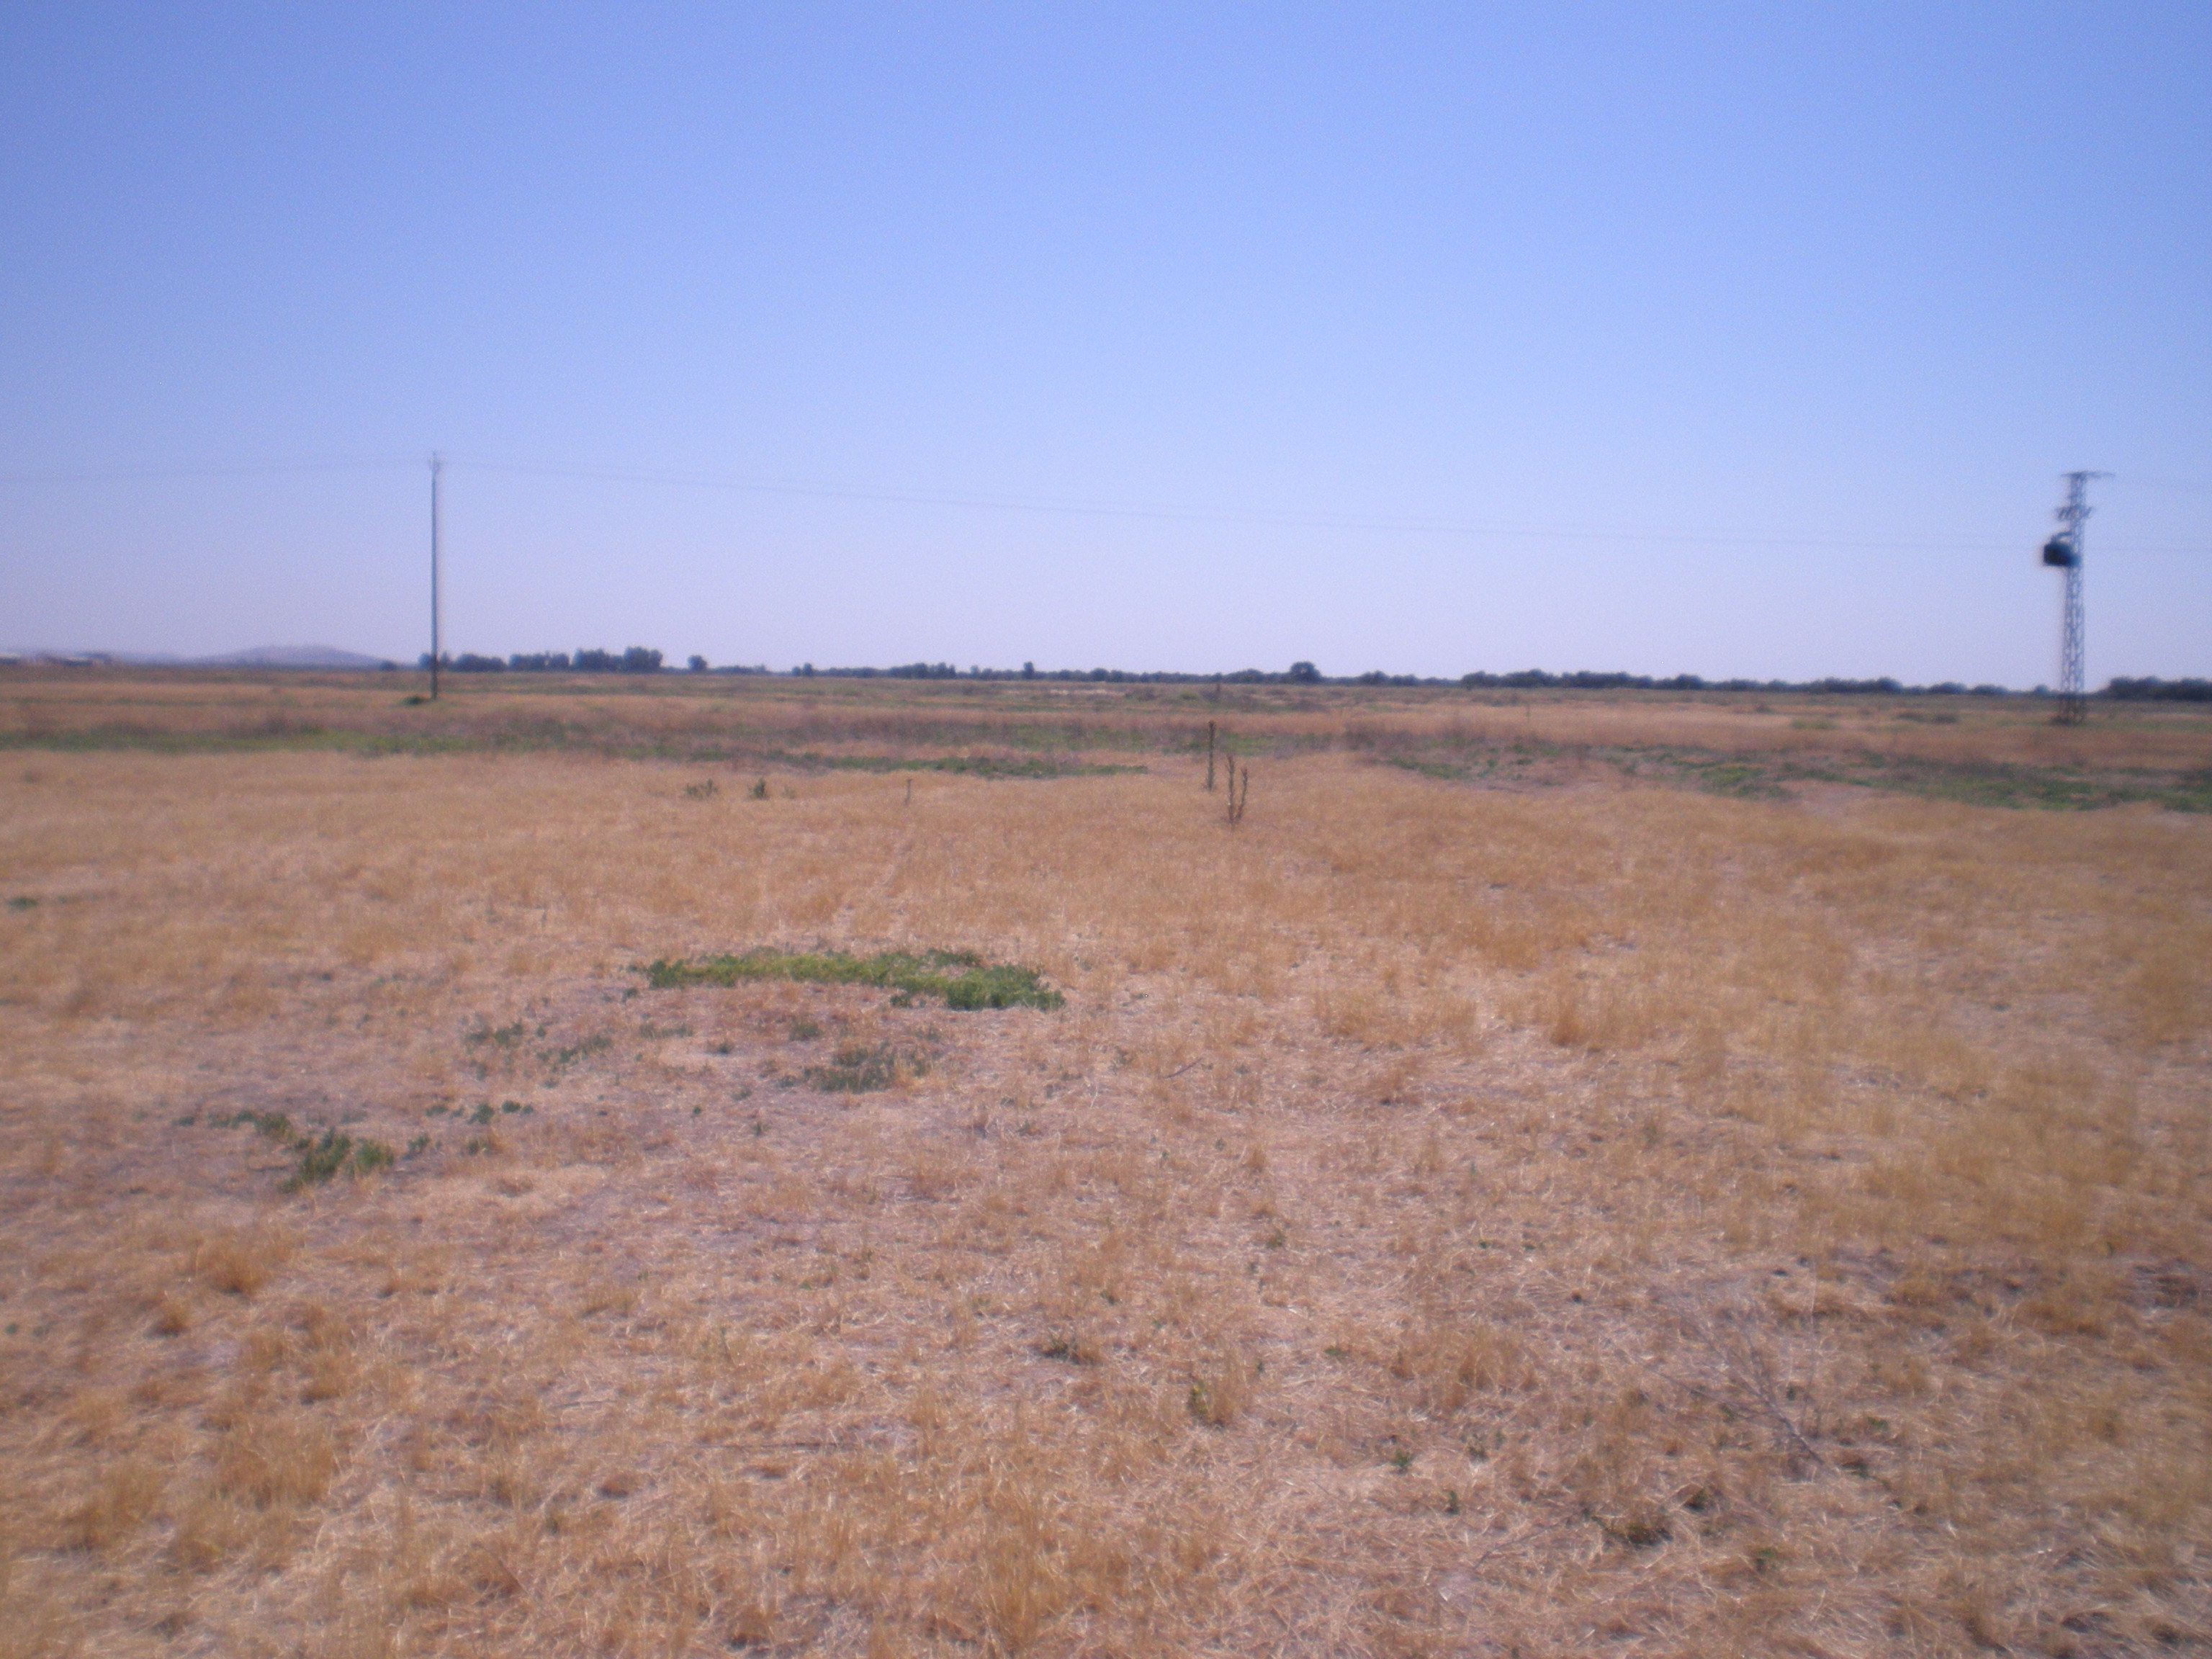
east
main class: Grassland
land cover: Grassland without tree/shrub cover
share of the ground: 10 - 25 %
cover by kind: unconsolidated bare surface 85 %, herbaceous plants 15 %
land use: Agriculture (excluding fallow land and kitchen gardens)
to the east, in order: Grassland without tree/shrub cover; Tracks; Grassland without tree/shrub cover; Electric lines; Grassland without tree/shrub cover
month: July
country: ES
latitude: 39.3387
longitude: -3.3027
